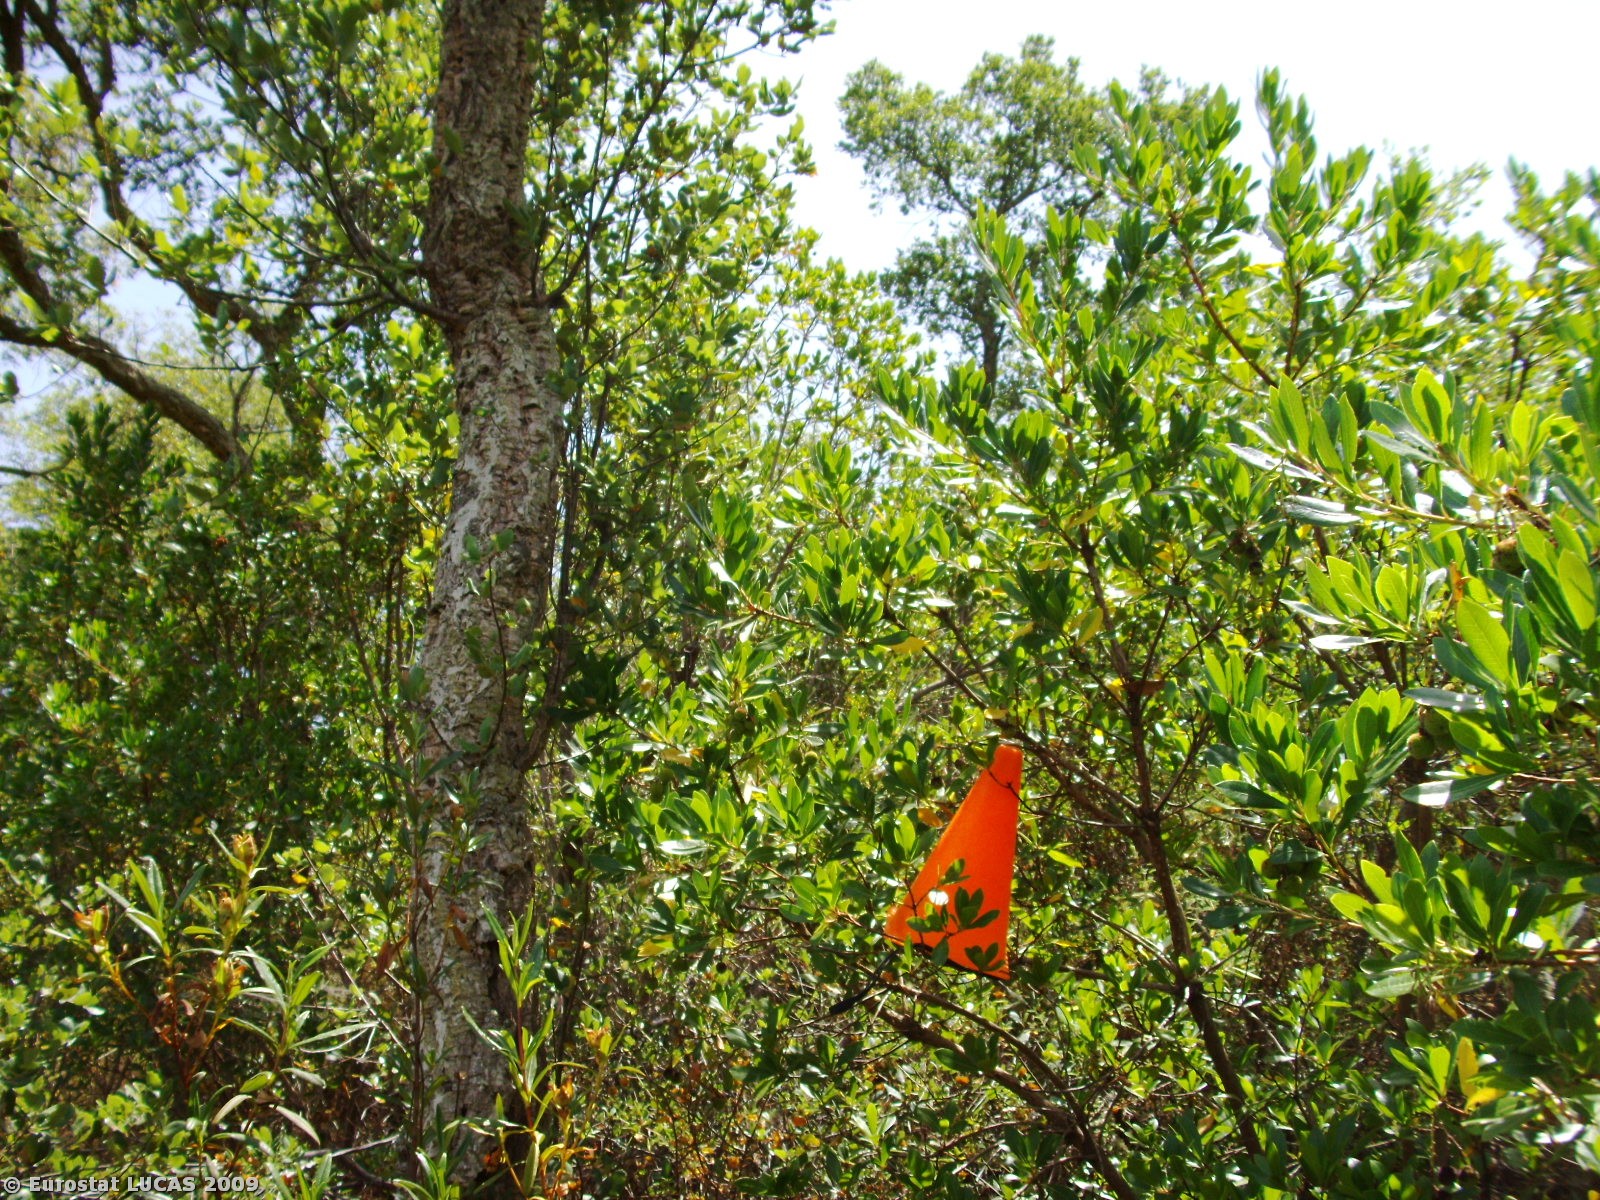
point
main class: Woodland
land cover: Broadleaved woodland
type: broadleaved evergreen forest
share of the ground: > 75 %
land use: Unused
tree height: > 5 m
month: June
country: PT
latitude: 37.4684
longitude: -8.5188
